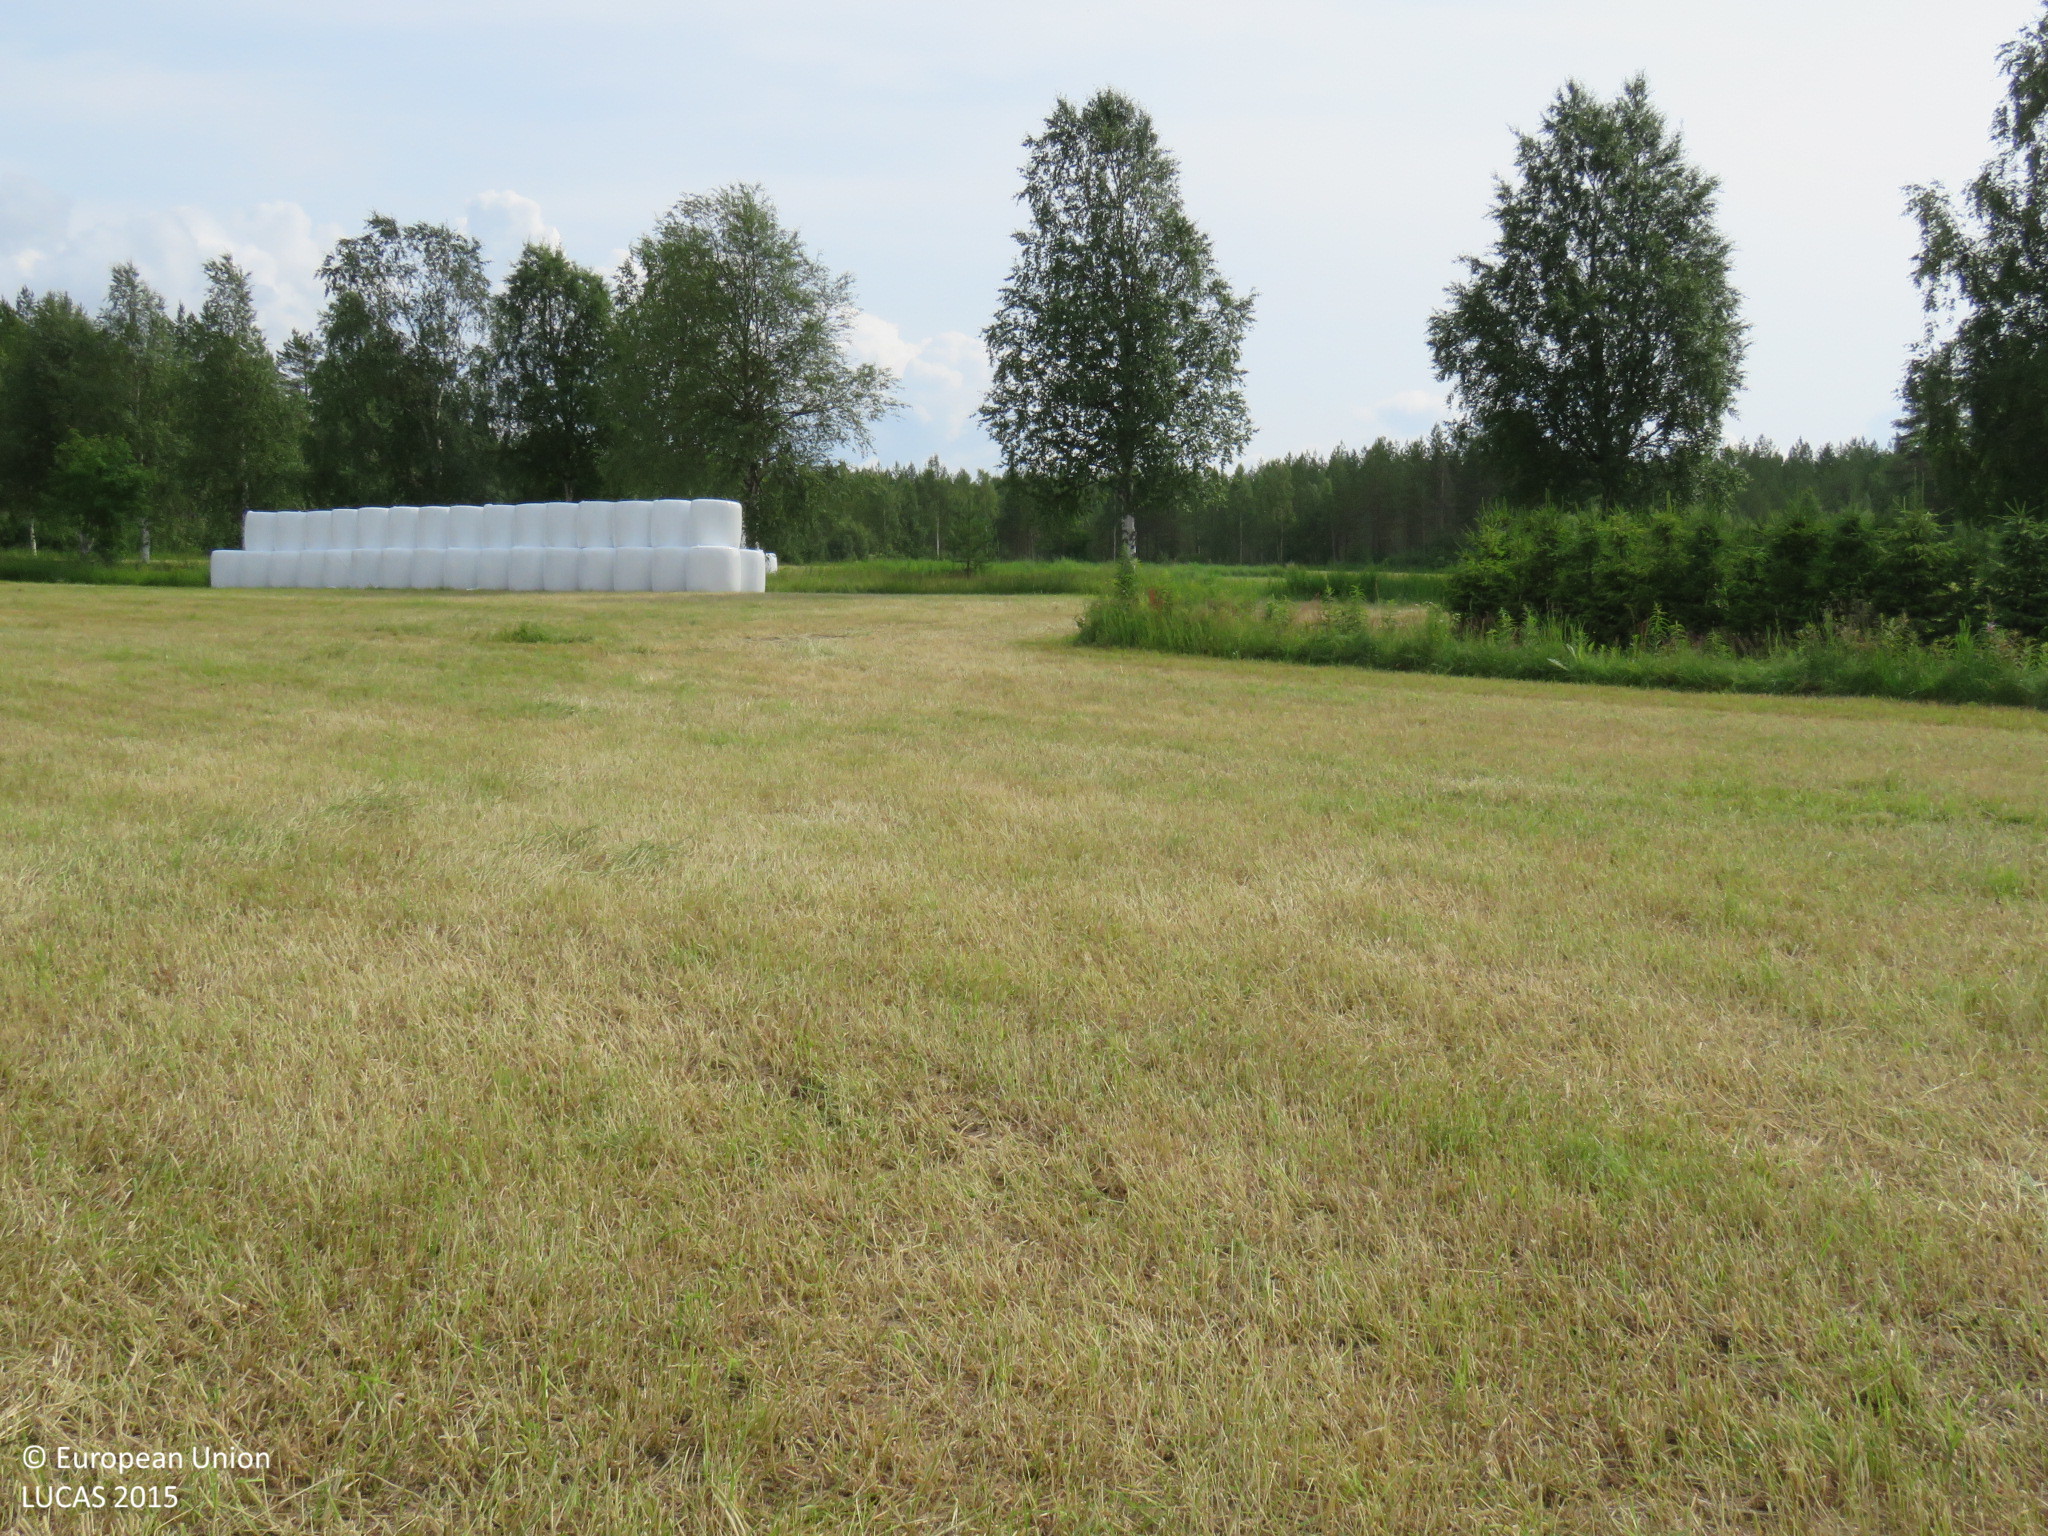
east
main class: Cropland
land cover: Temporary grasslands
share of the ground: > 75 %
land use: Agriculture (excluding fallow land and kitchen gardens)
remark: Harvested field
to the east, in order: Temporary grasslands; Ditches and canals; Grassland without tree/shrub cover; Temporary grasslands; Lines of trees; Grass margins; Paved roads, cycling and walking lanes; Temporary grasslands; Abandoned hedges; Ditches and canals; Pine dominated coniferous woodland
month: July
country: FI
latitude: 64.5345
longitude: 26.7766
